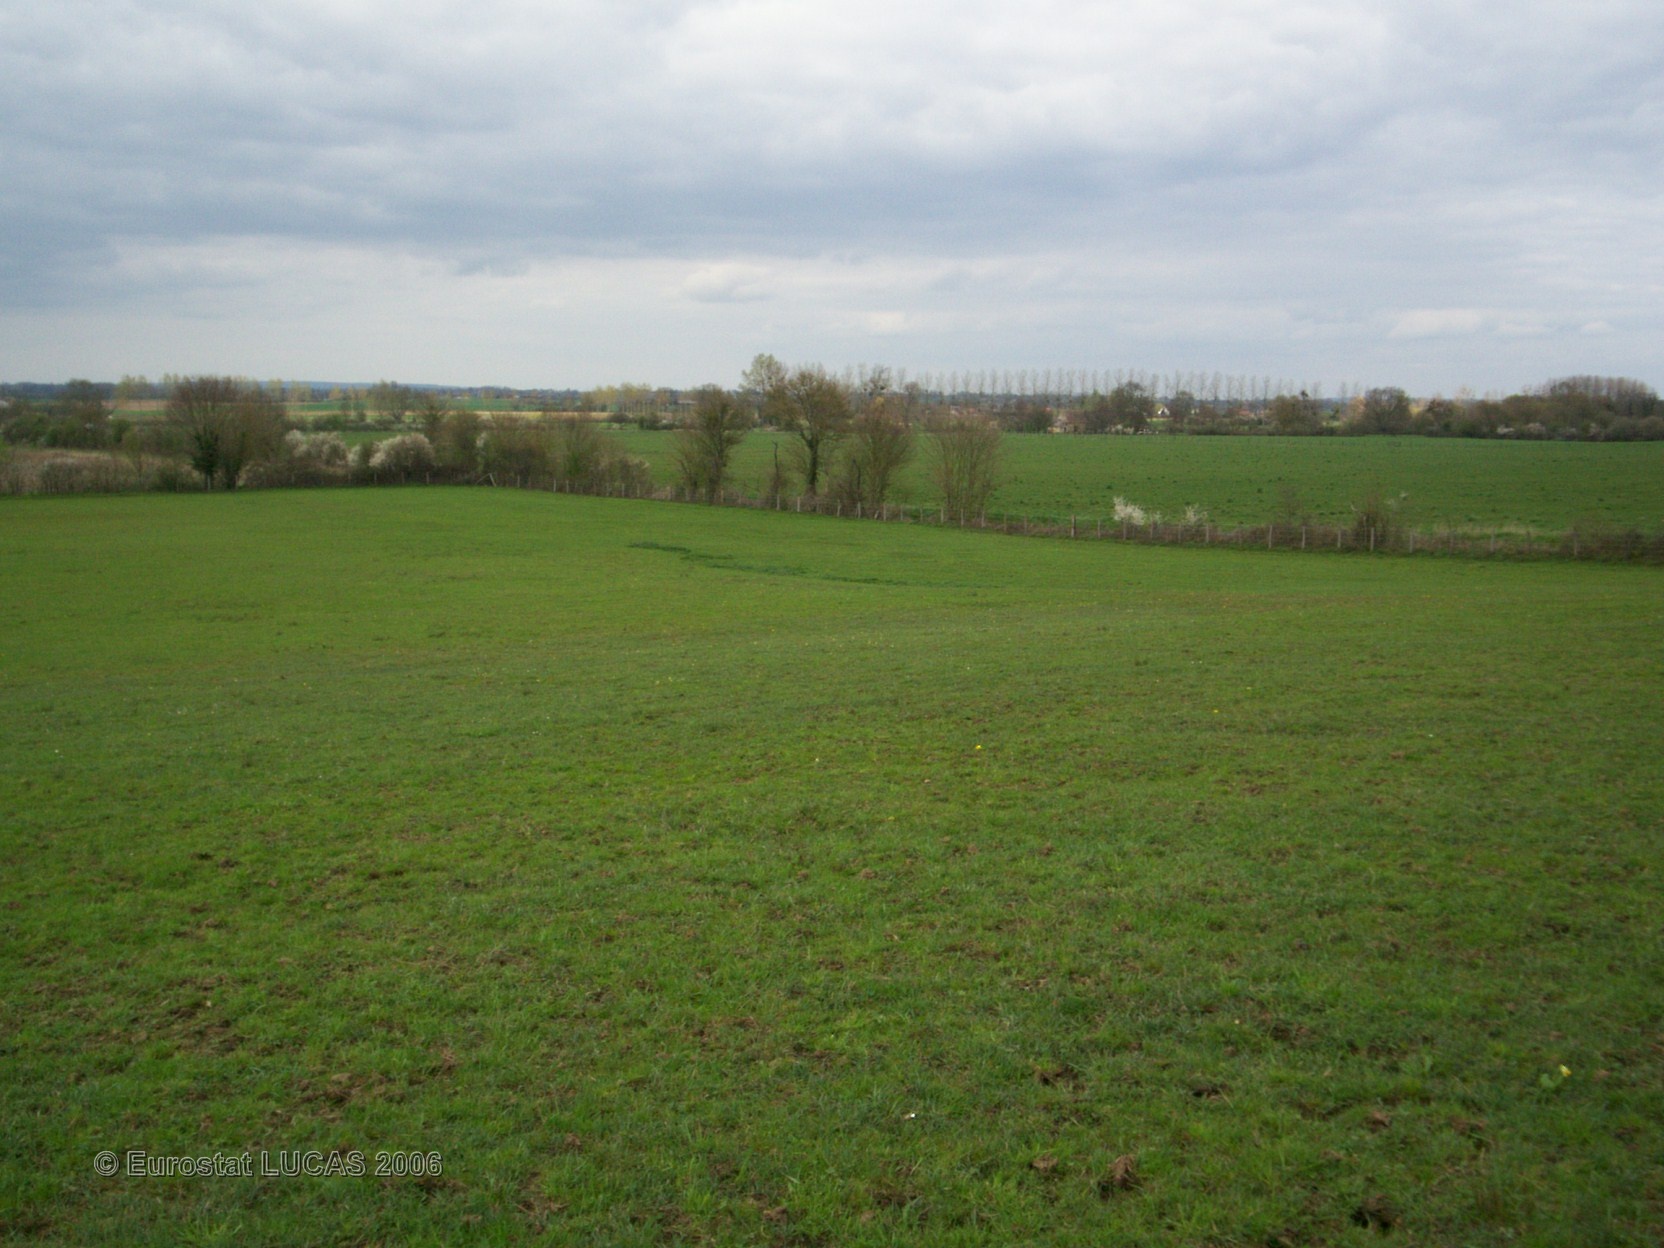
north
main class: Grassland
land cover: Grassland without tree/shrub cover
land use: Agriculture (excluding fallow land and kitchen gardens)
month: April
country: FR
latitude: 48.2340
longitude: 0.3482
